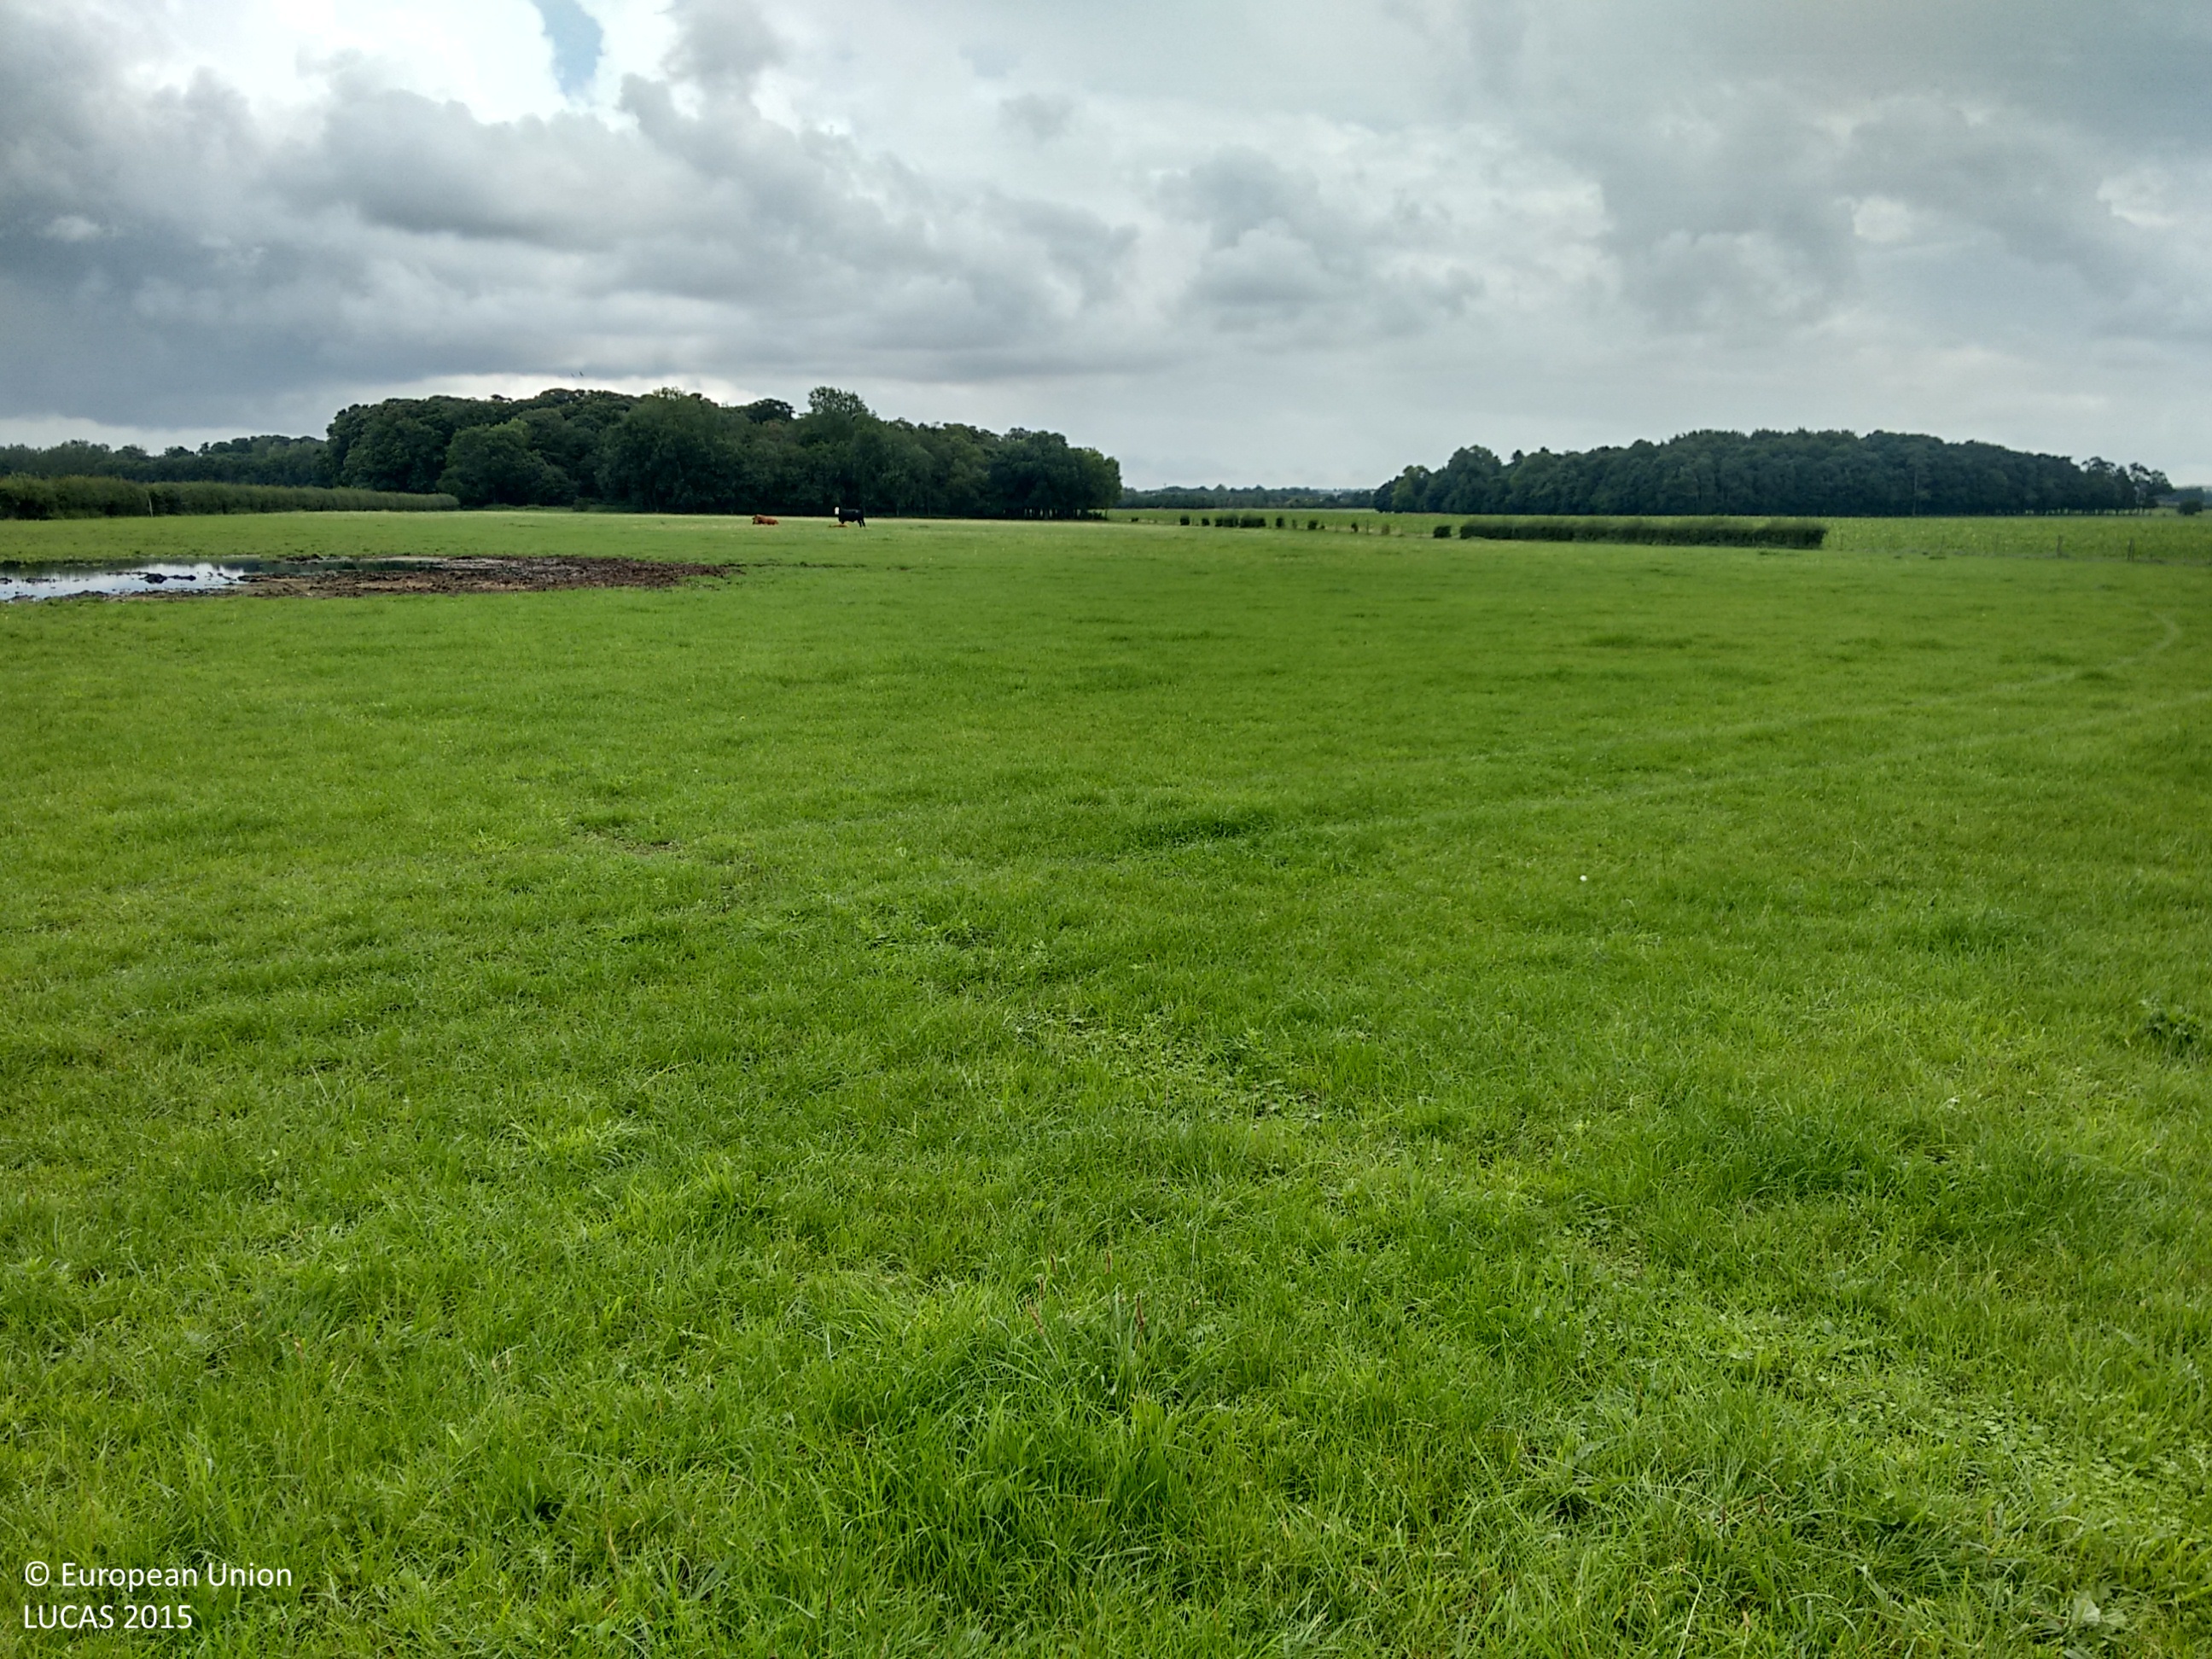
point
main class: Grassland
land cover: Grassland without tree/shrub cover
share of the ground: > 75 %
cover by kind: herbaceous plants 100 %
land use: Agriculture (excluding fallow land and kitchen gardens)
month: September
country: GB
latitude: 52.2999
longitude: 0.4549
